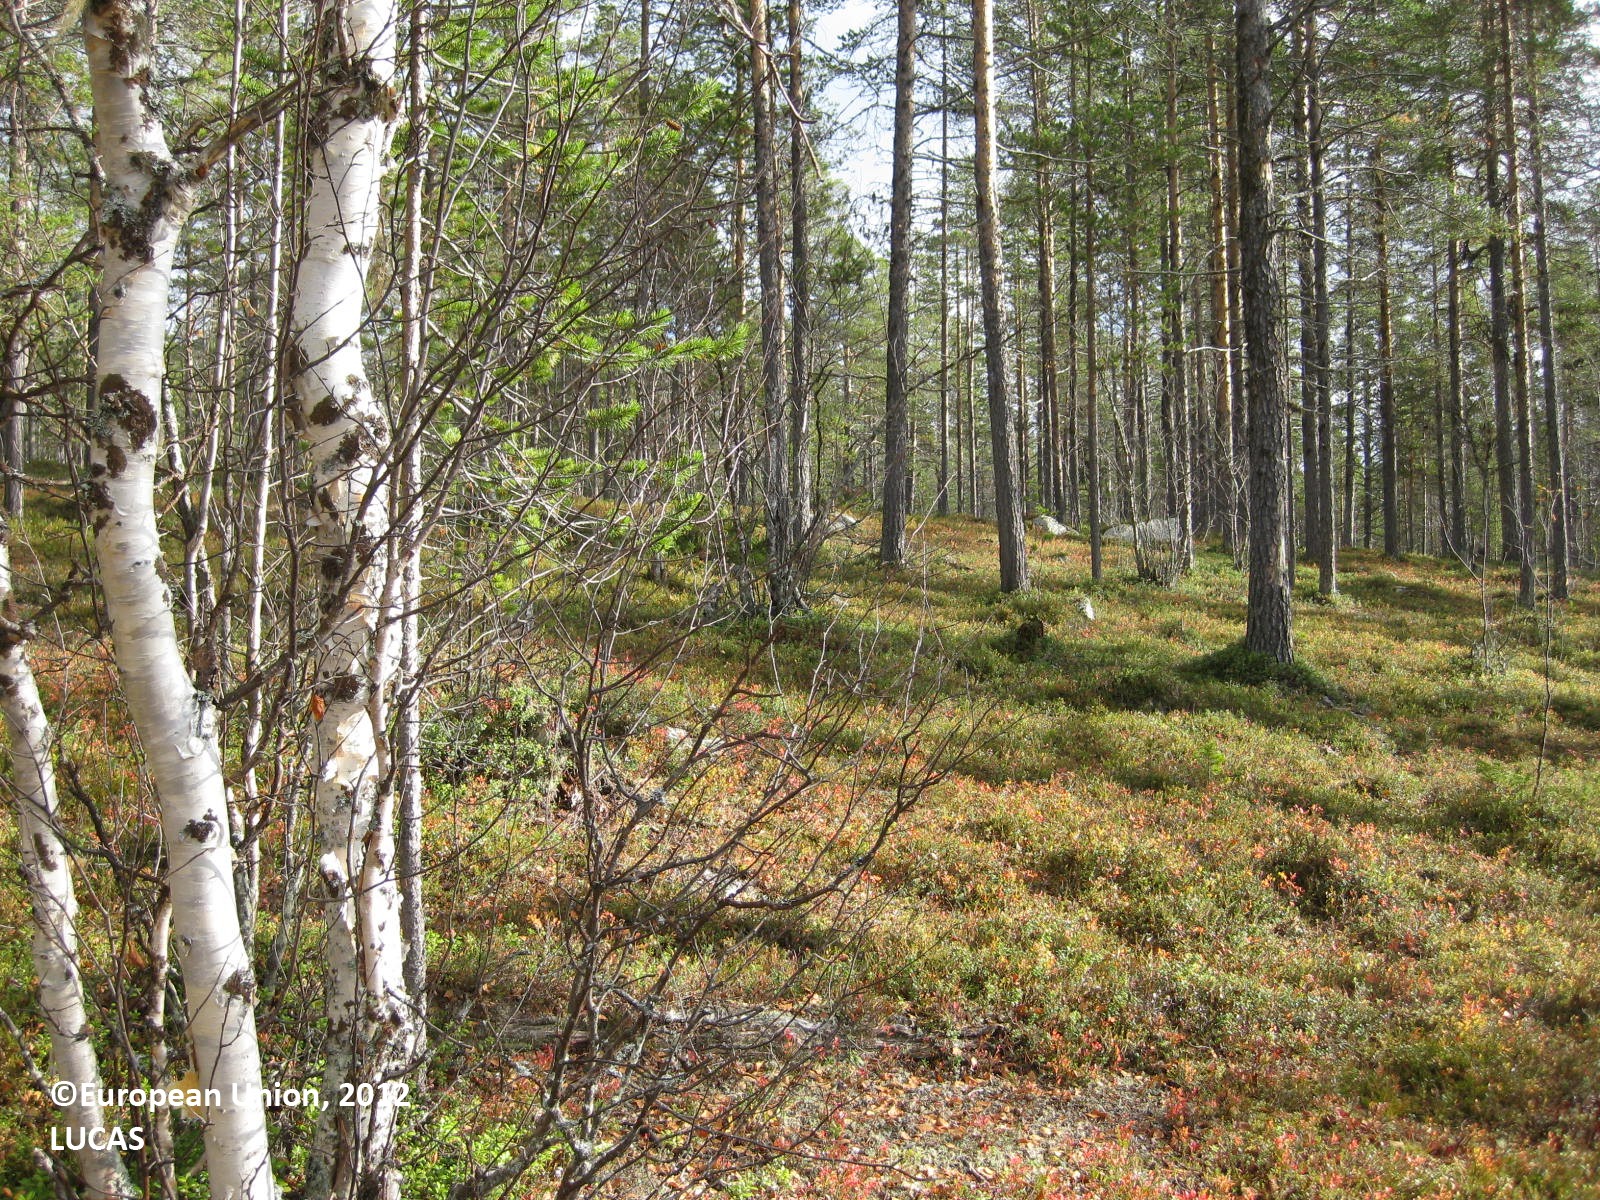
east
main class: Woodland
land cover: Pine dominated coniferous woodland
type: boreal forest
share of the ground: 50 - 75 %
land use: Forestry
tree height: > 5 m
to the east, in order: Pine dominated coniferous woodland; Tracks; Pine dominated coniferous woodland
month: September
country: FI
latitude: 68.0544
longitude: 23.7505
